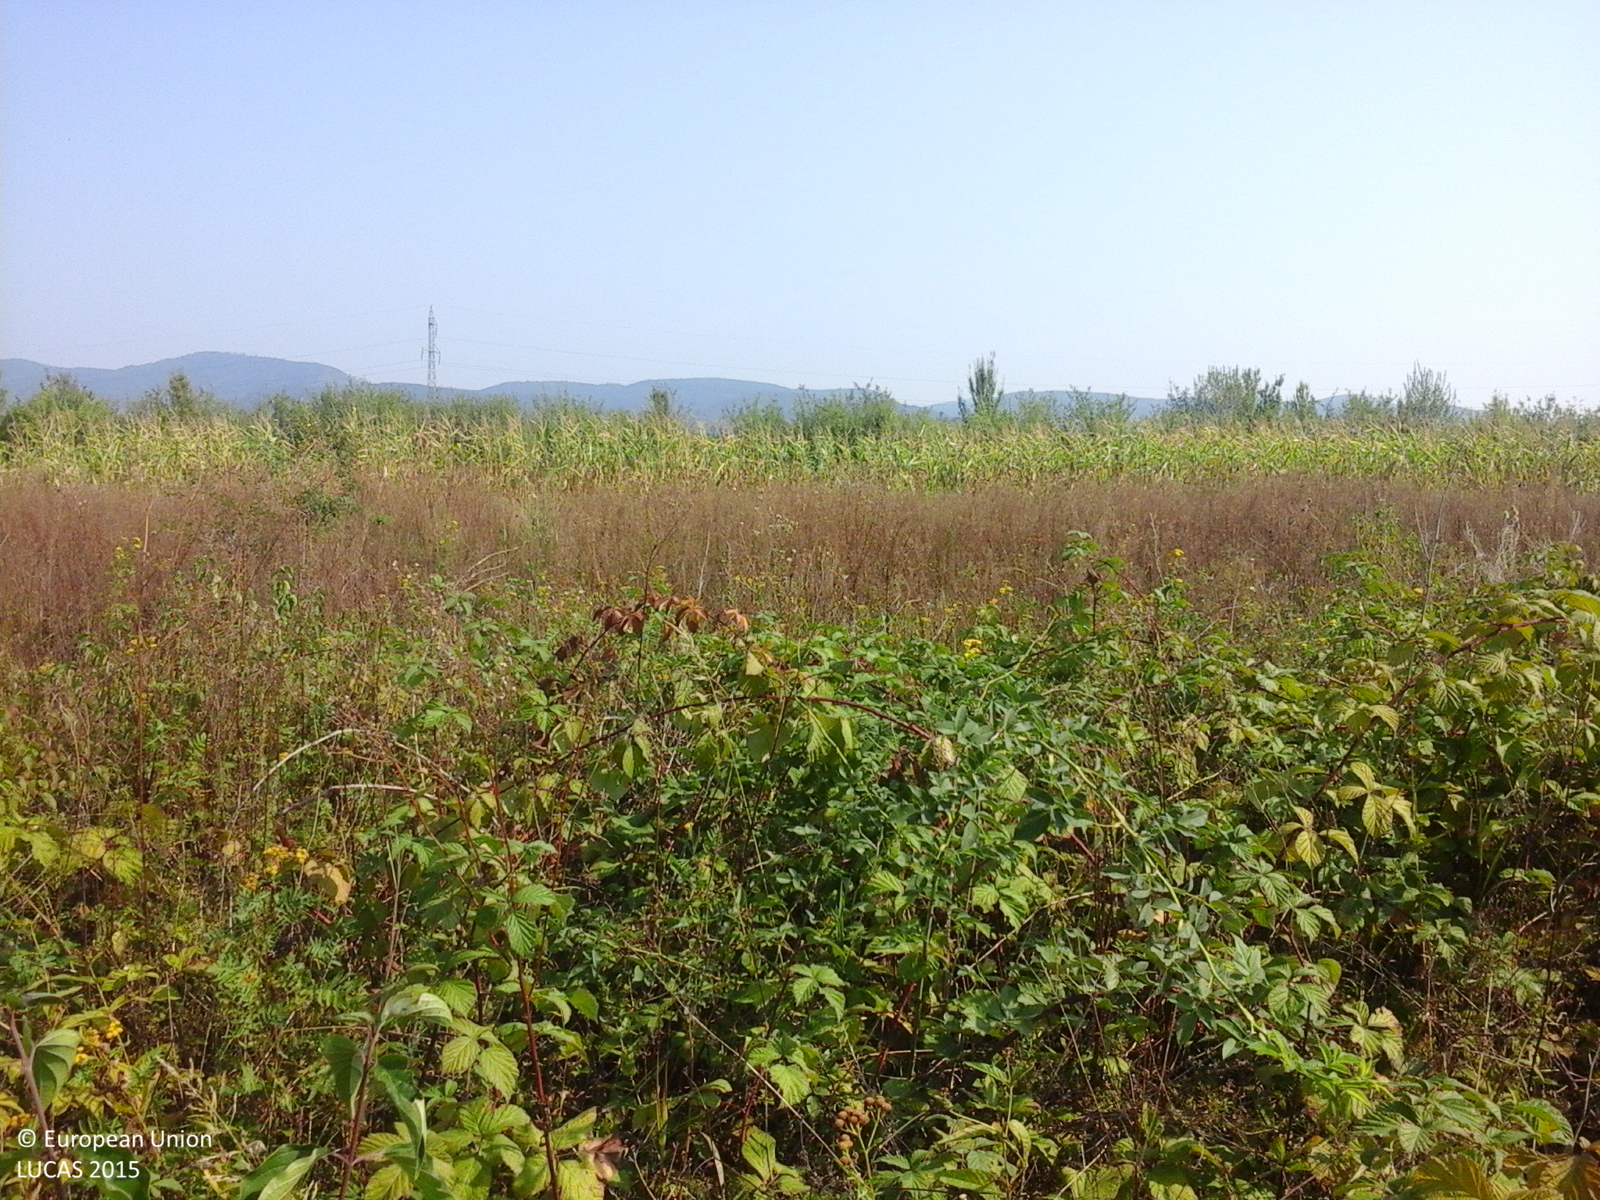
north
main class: Grassland
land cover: Grassland with sparse tree/shrub cover
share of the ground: > 75 %
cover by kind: herbaceous plants 85 %, shrubs 10 %, broadleaved forest trees 5 %
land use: Agriculture (excluding fallow land and kitchen gardens)
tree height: < 5 m
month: August
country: RO
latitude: 46.3128
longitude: 22.2930
